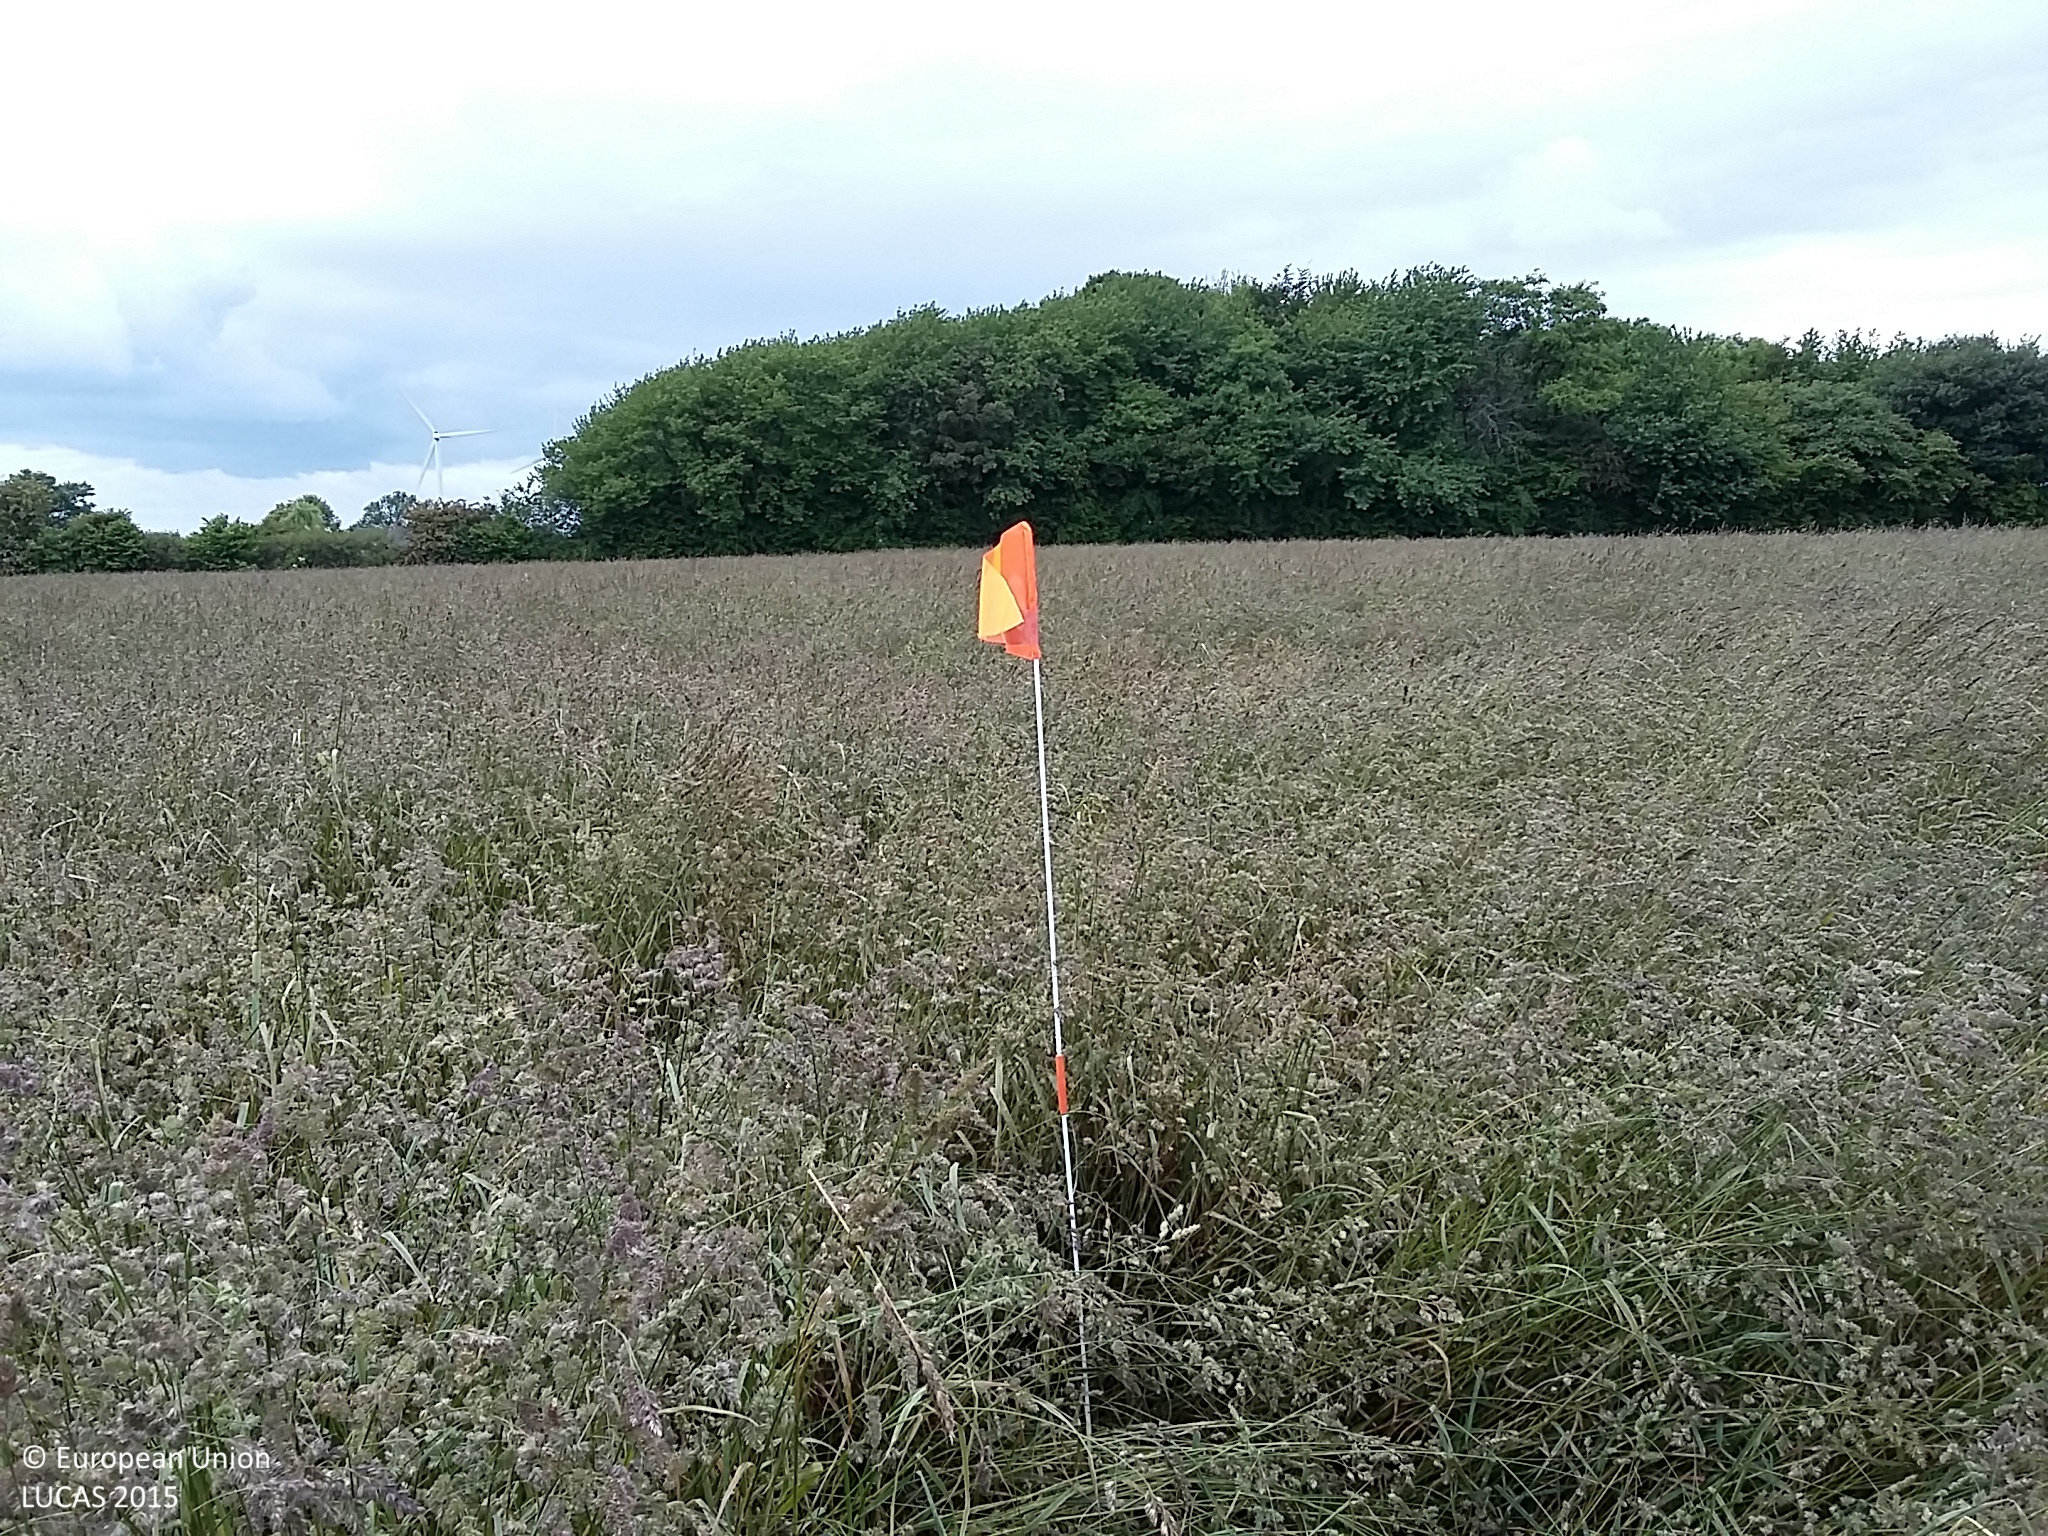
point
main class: Cropland
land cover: Temporary grasslands
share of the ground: > 75 %
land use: Agriculture (excluding fallow land and kitchen gardens)
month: June
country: DK
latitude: 54.9093
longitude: 10.7637
